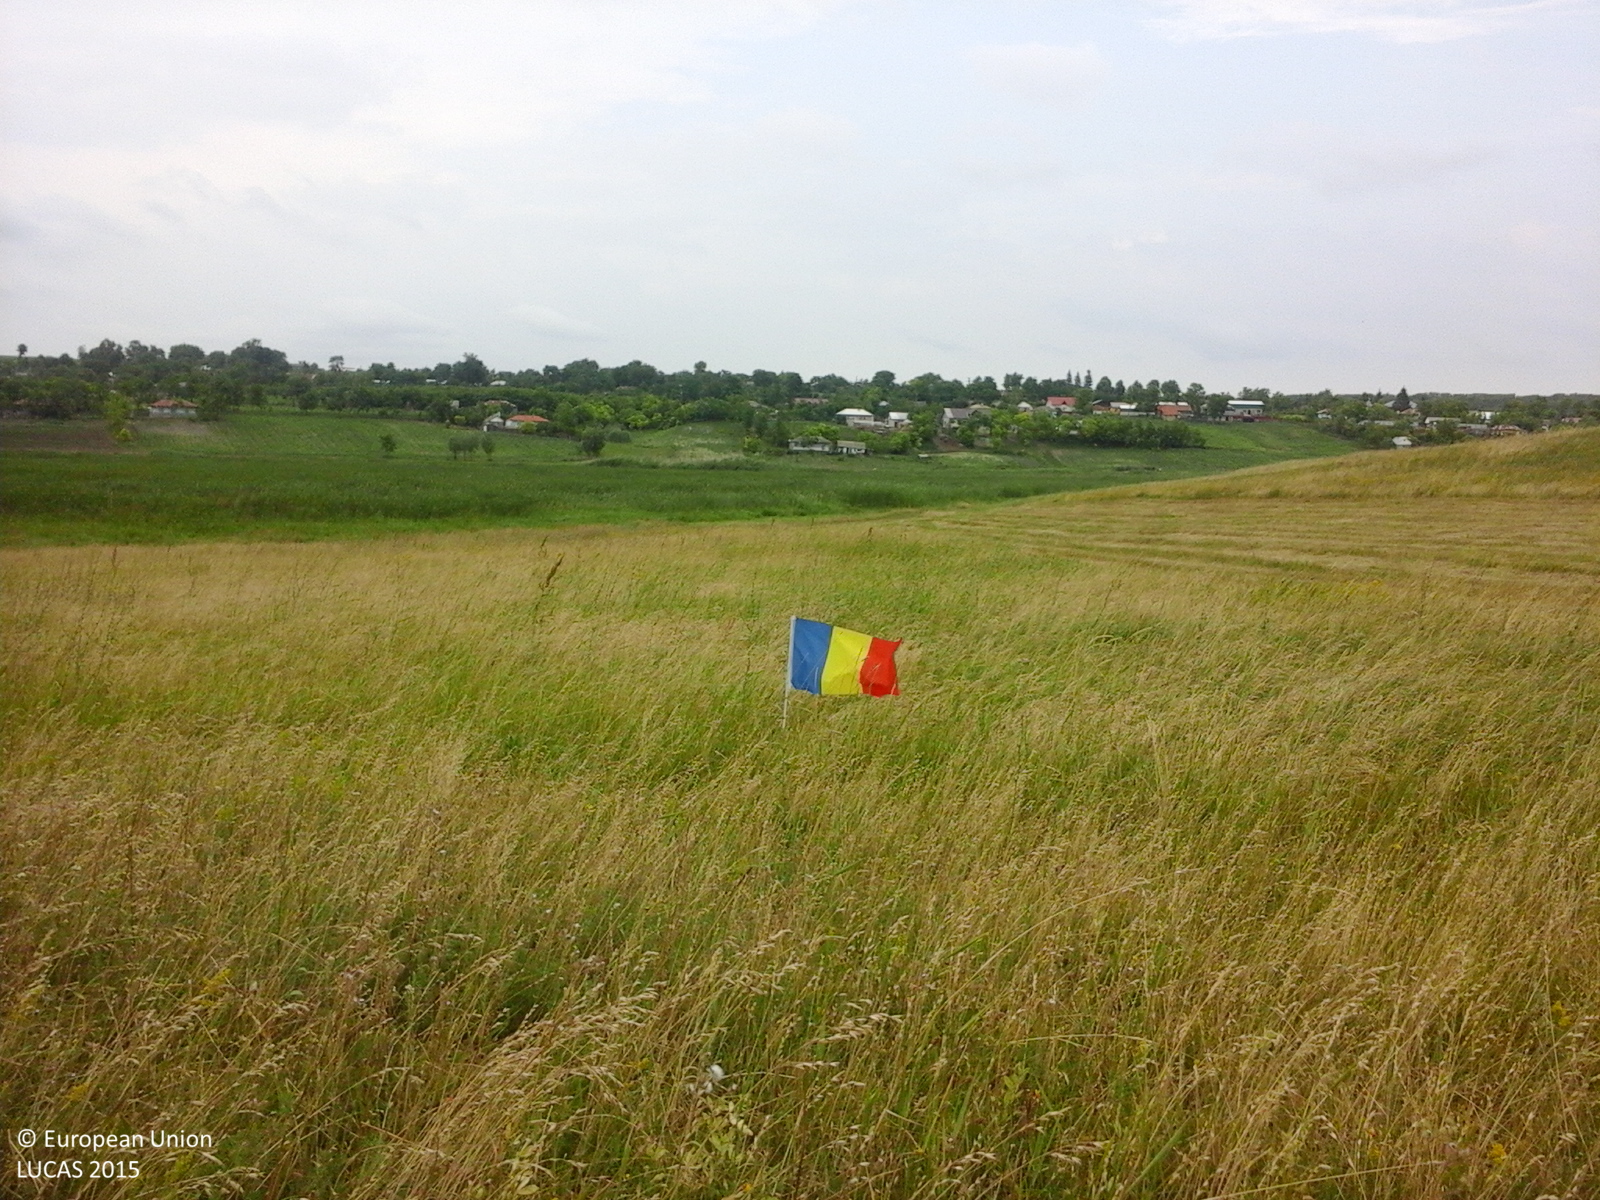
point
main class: Grassland
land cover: Grassland without tree/shrub cover
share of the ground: > 75 %
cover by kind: herbaceous plants 100 %
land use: Agriculture (excluding fallow land and kitchen gardens)
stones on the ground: < 10 %
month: June
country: RO
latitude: 47.8319
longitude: 26.6199
